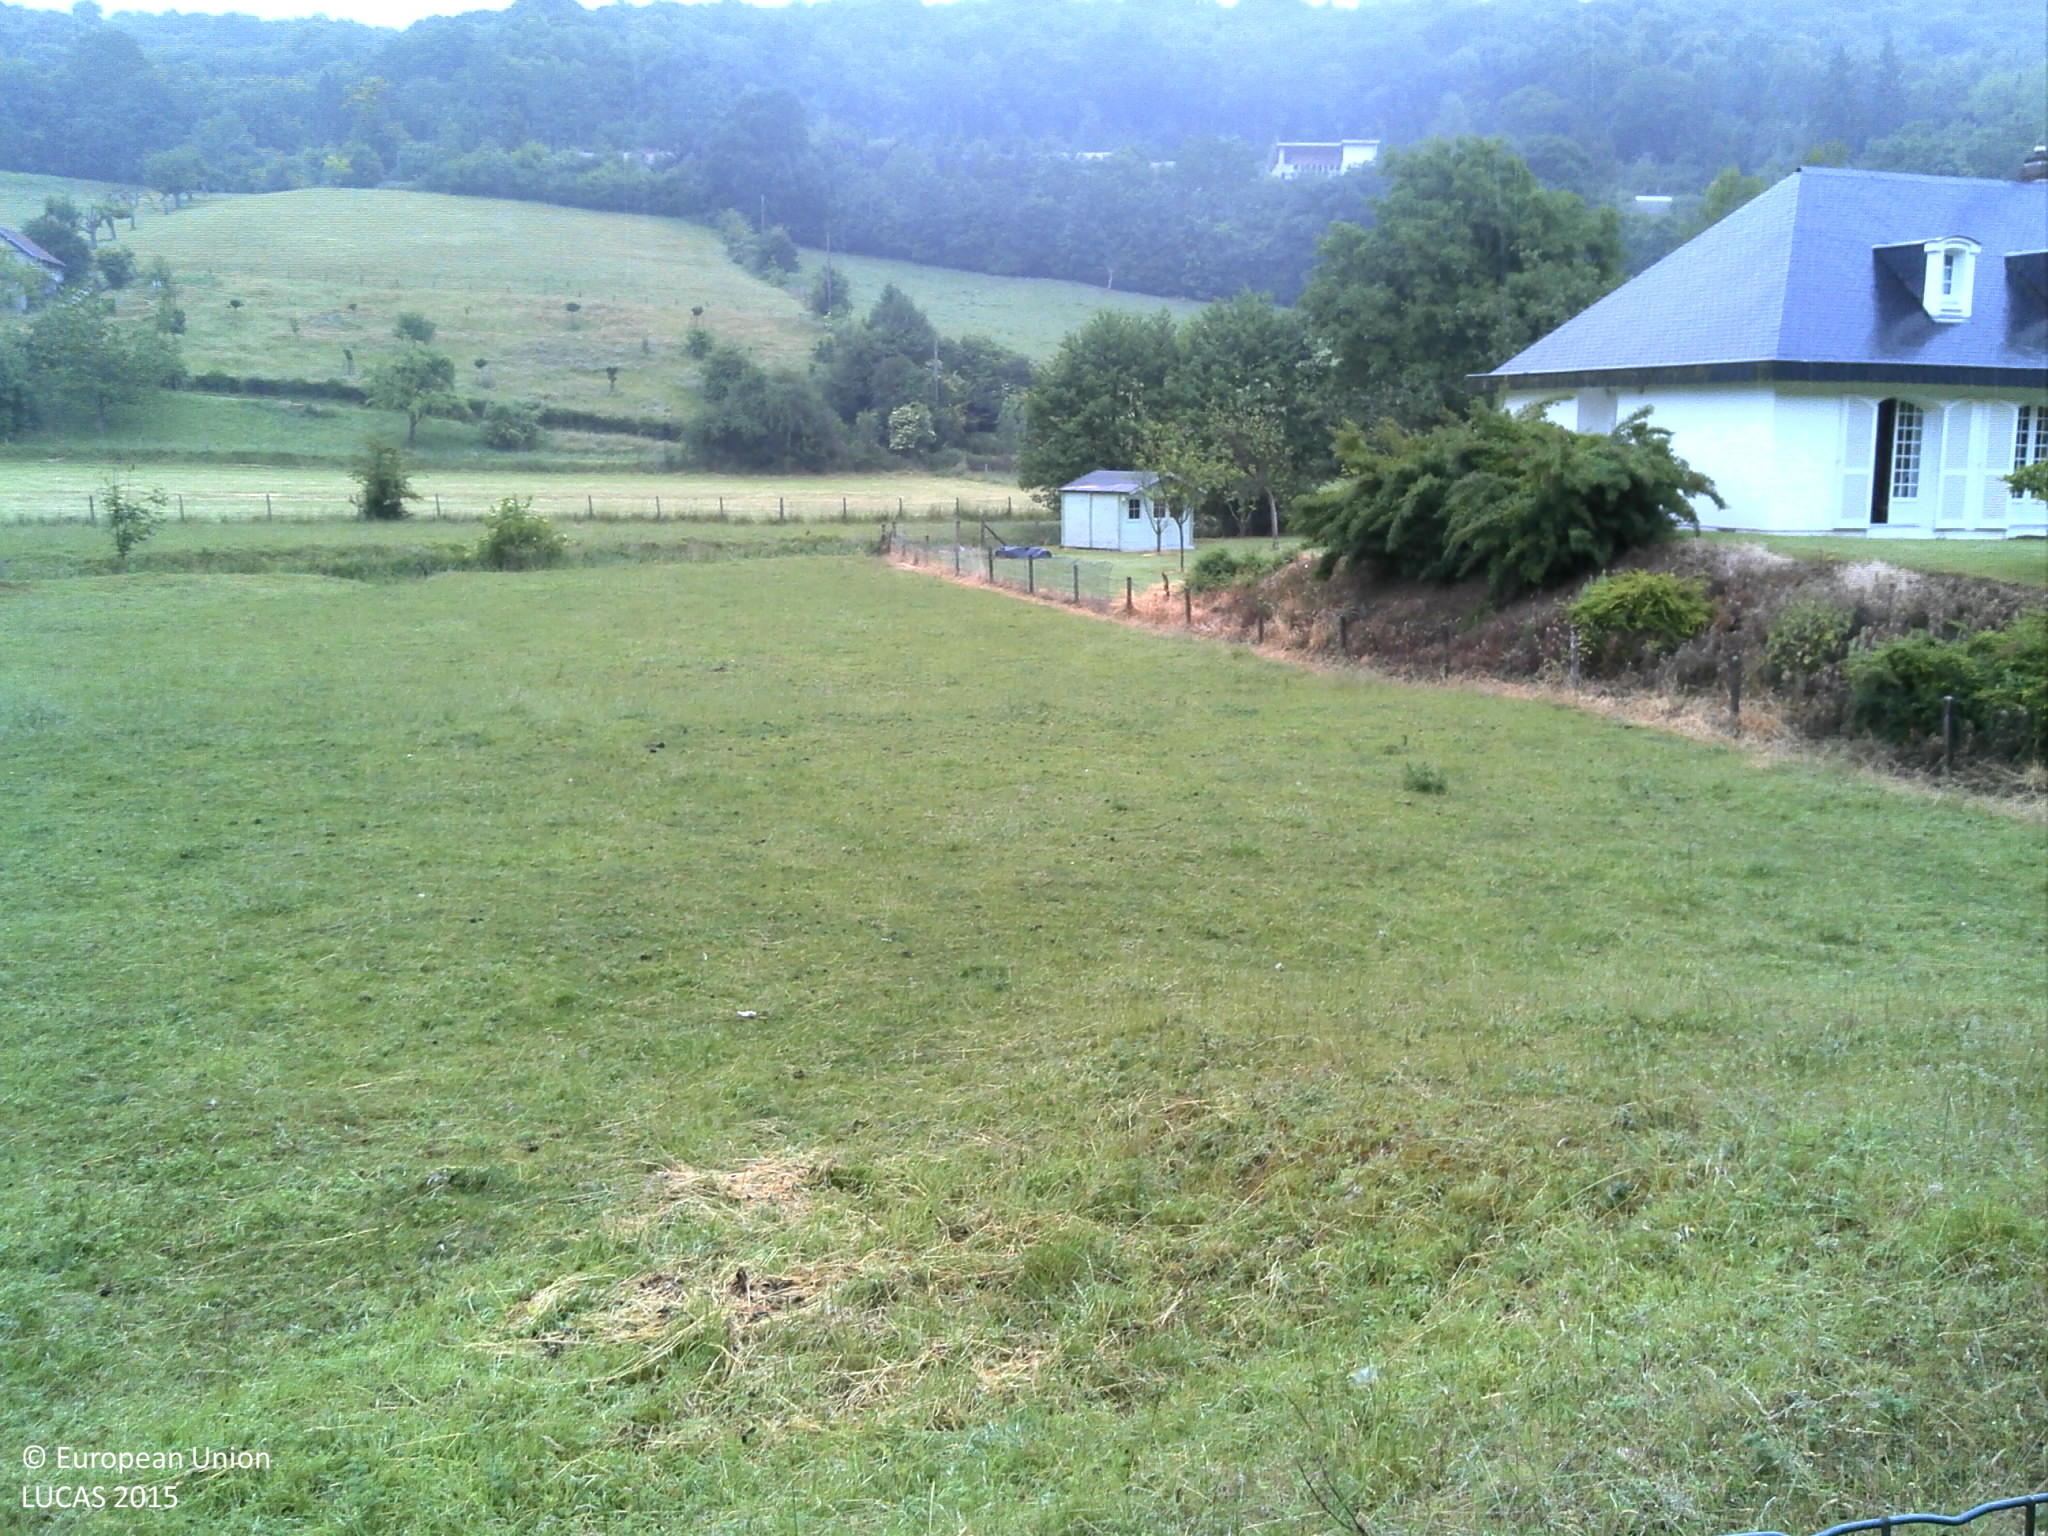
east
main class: Grassland
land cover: Grassland with sparse tree/shrub cover
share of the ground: > 75 %
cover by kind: herbaceous plants 95 %, broadleaved forest trees 5 %
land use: Agriculture (excluding fallow land and kitchen gardens)
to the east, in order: Grassland with sparse tree/shrub cover; Rivers and streams; Fences; Grassland without tree/shrub cover; Fences; Grassland without tree/shrub cover; Broadleaved woodland; Electric lines; Paved roads, cycling and walking lanes; Abandoned hedges; Grassland with sparse tree/shrub cover; Fences; Grassland without tree/shrub cover
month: June
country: FR
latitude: 49.4606
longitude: 1.1628
